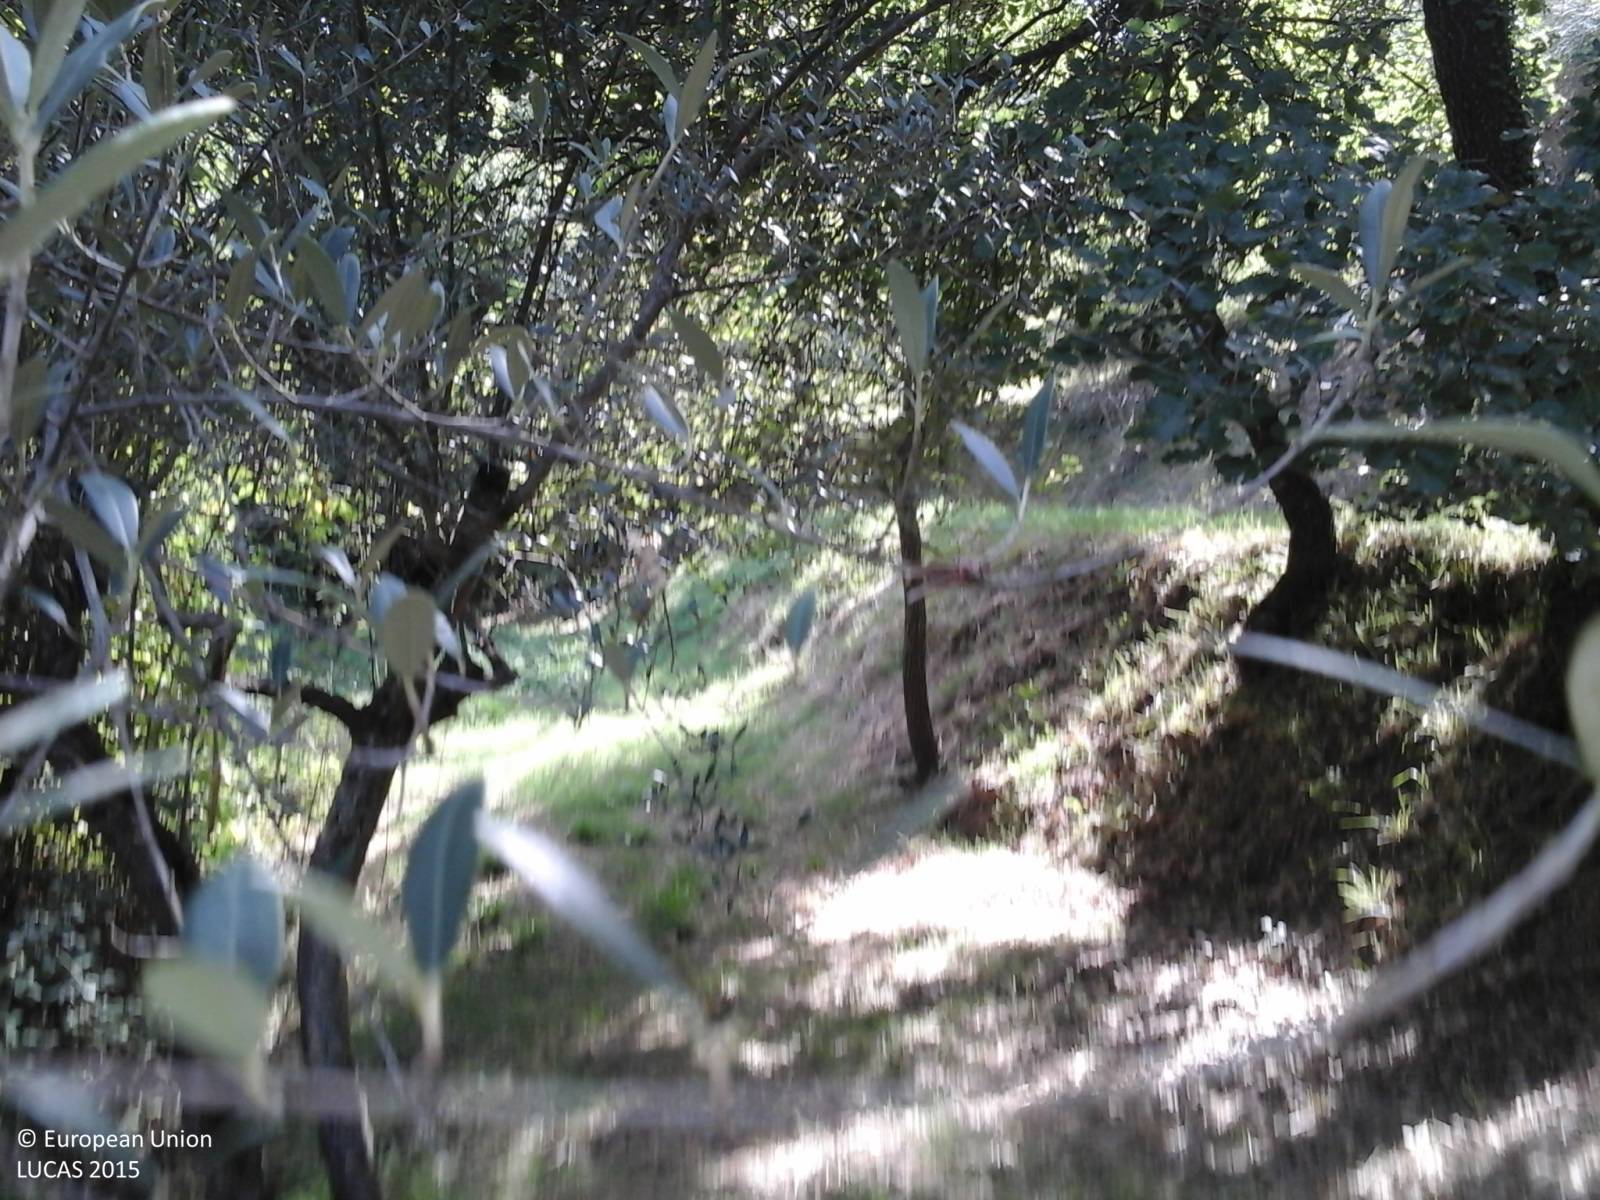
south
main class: Woodland
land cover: Broadleaved woodland
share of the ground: 50 - 75 %
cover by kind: broadleaved forest trees 70 %, shrubs 30 %
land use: Forestry
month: September
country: IT
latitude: 43.0298
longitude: 12.0924
